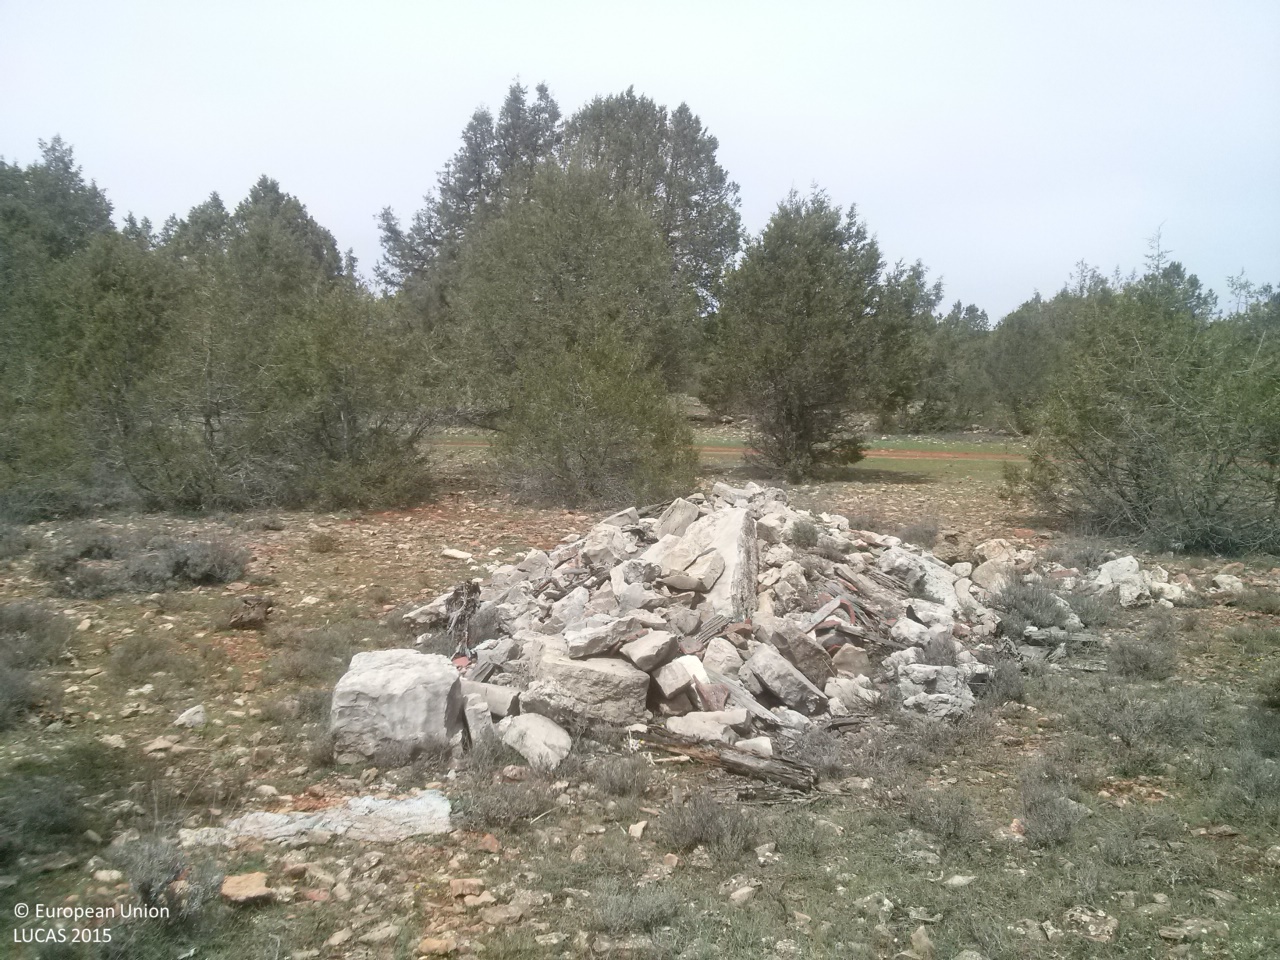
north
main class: Woodland
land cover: Other coniferous woodland
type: coniferous forest of the mediterranean region
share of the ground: 10 - 25 %
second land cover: Grassland without tree/shrub cover
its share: 50 - 75 %
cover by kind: herbaceous plants 60 %, coniferous forest trees 20 %, unconsolidated bare surface 15 %, shrubs 5 %
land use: Forestry
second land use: Agriculture (excluding fallow land and kitchen gardens)
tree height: > 5 m
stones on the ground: > 50 %
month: April
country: ES
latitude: 40.0410
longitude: -1.8386
